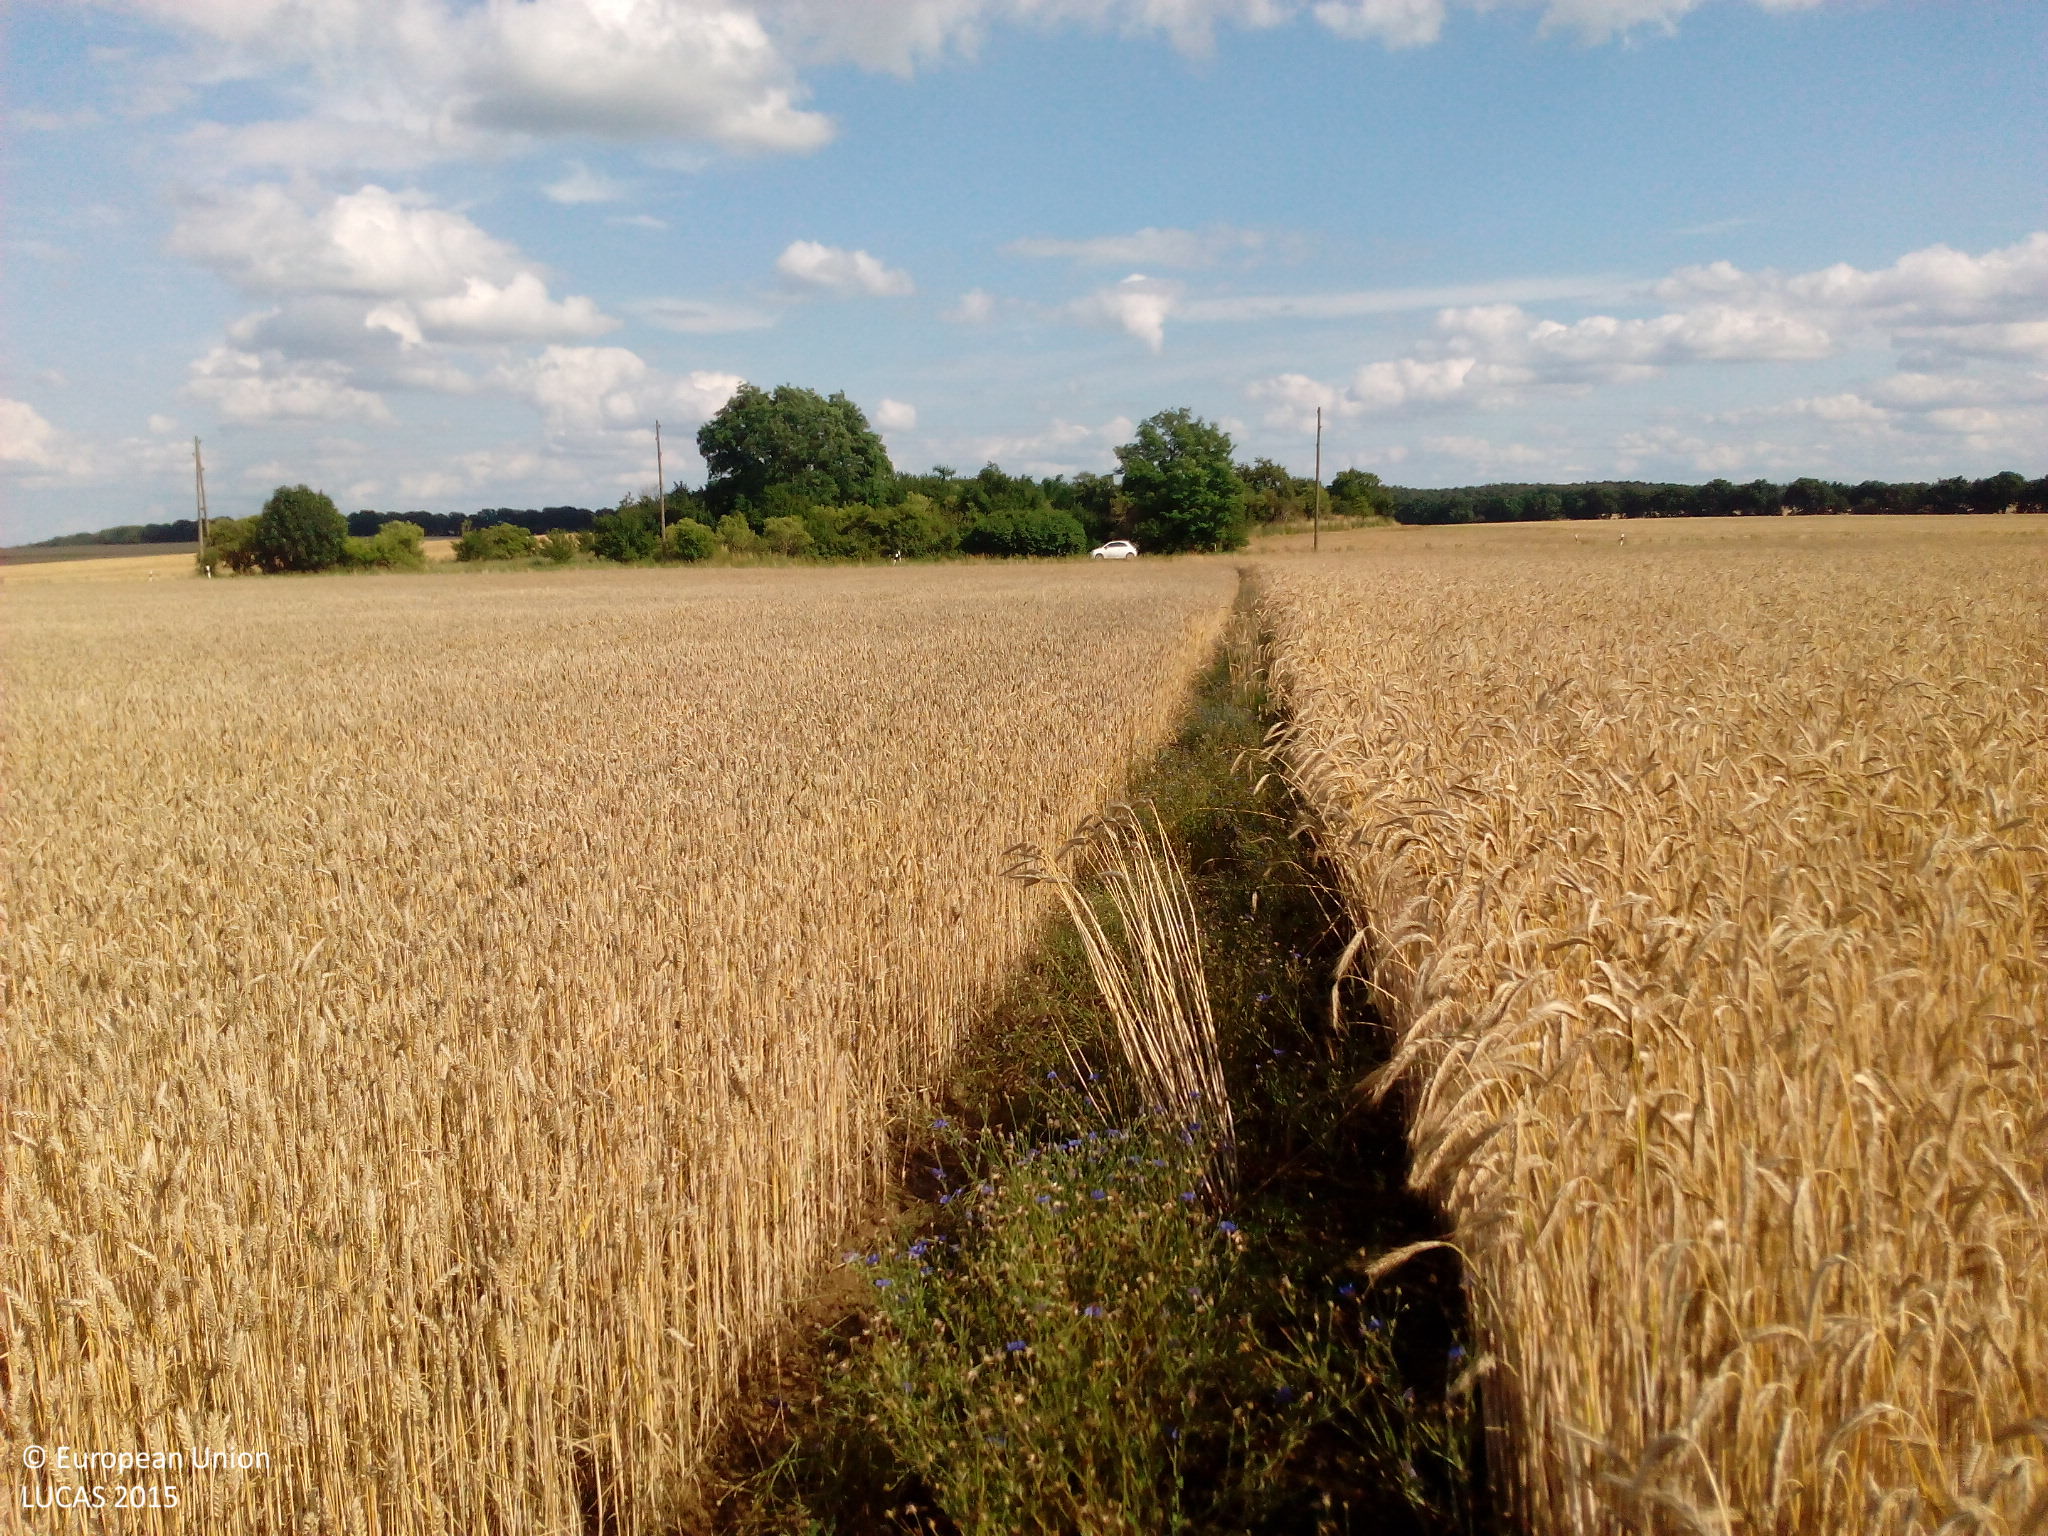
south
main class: Cropland
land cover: Rye
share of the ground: > 75 %
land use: Agriculture (excluding fallow land and kitchen gardens)
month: July
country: DE
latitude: 52.6396
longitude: 12.4674
